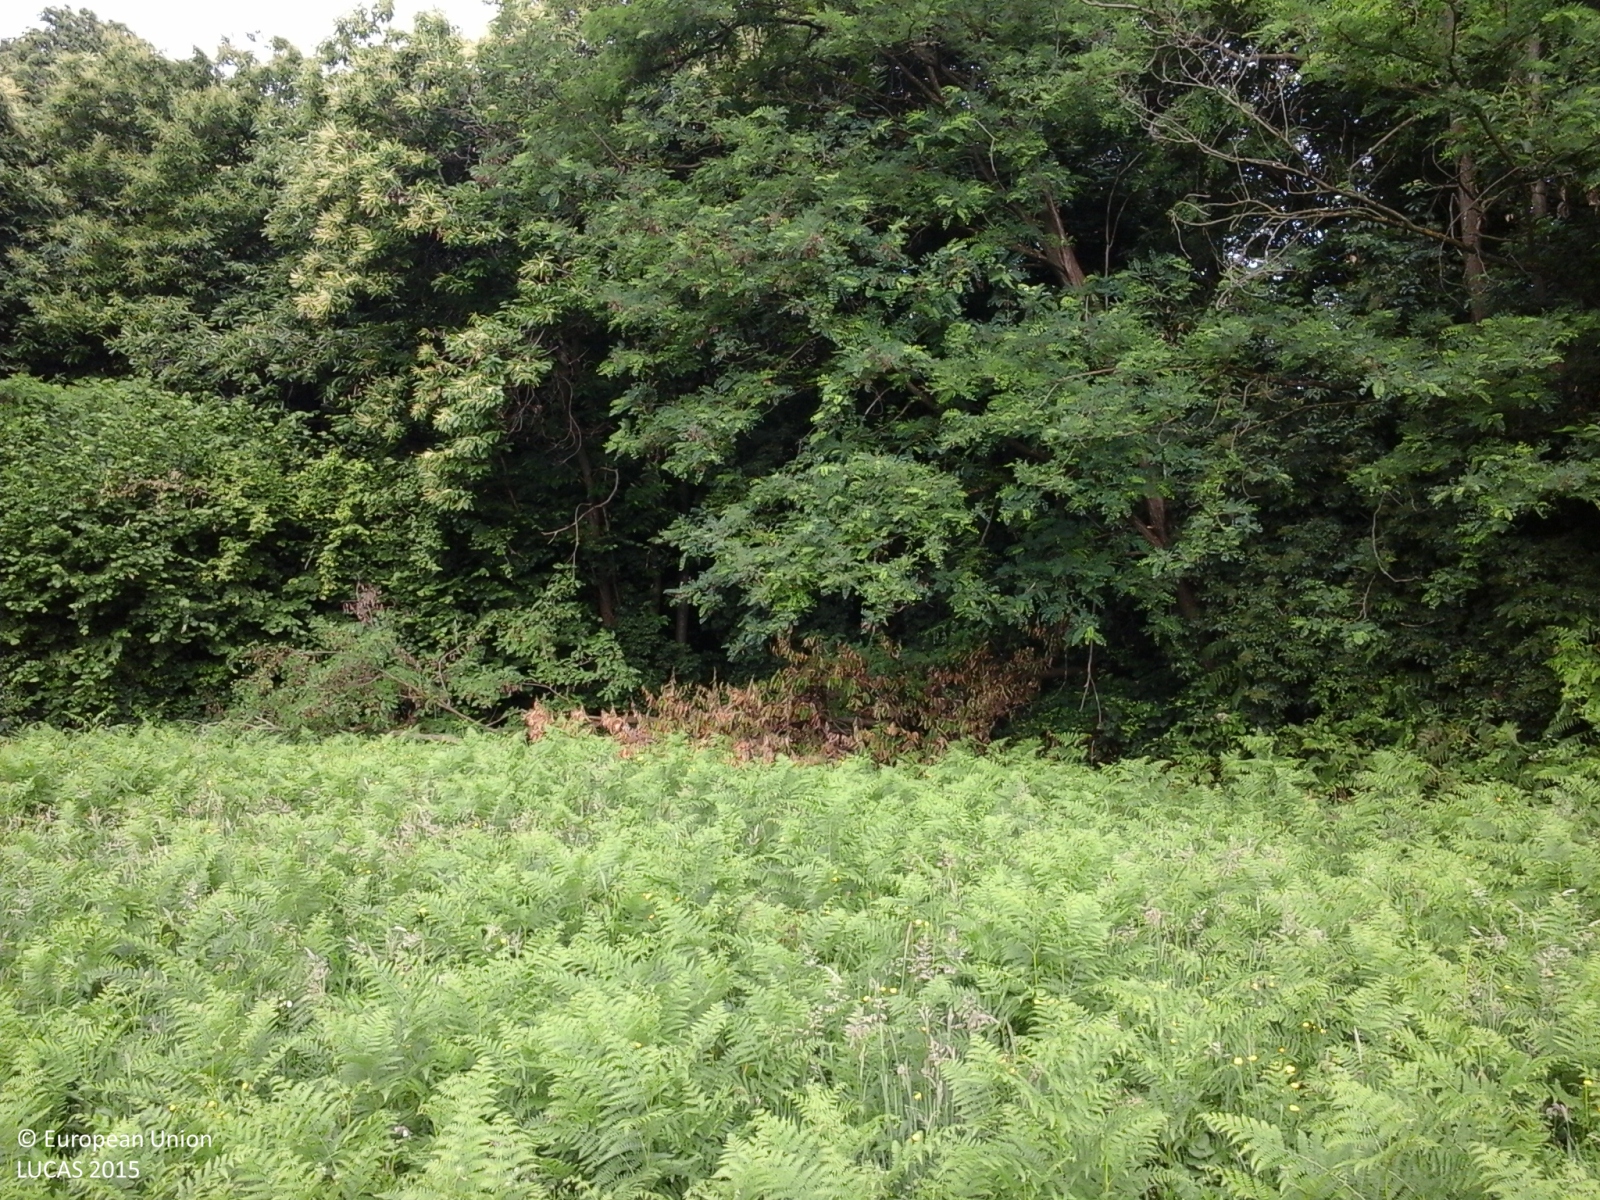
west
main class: Grassland
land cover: Grassland without tree/shrub cover
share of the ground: > 75 %
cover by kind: herbaceous plants 100 %
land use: Agriculture (excluding fallow land and kitchen gardens)
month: June
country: IT
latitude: 45.6486
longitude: 10.0640
